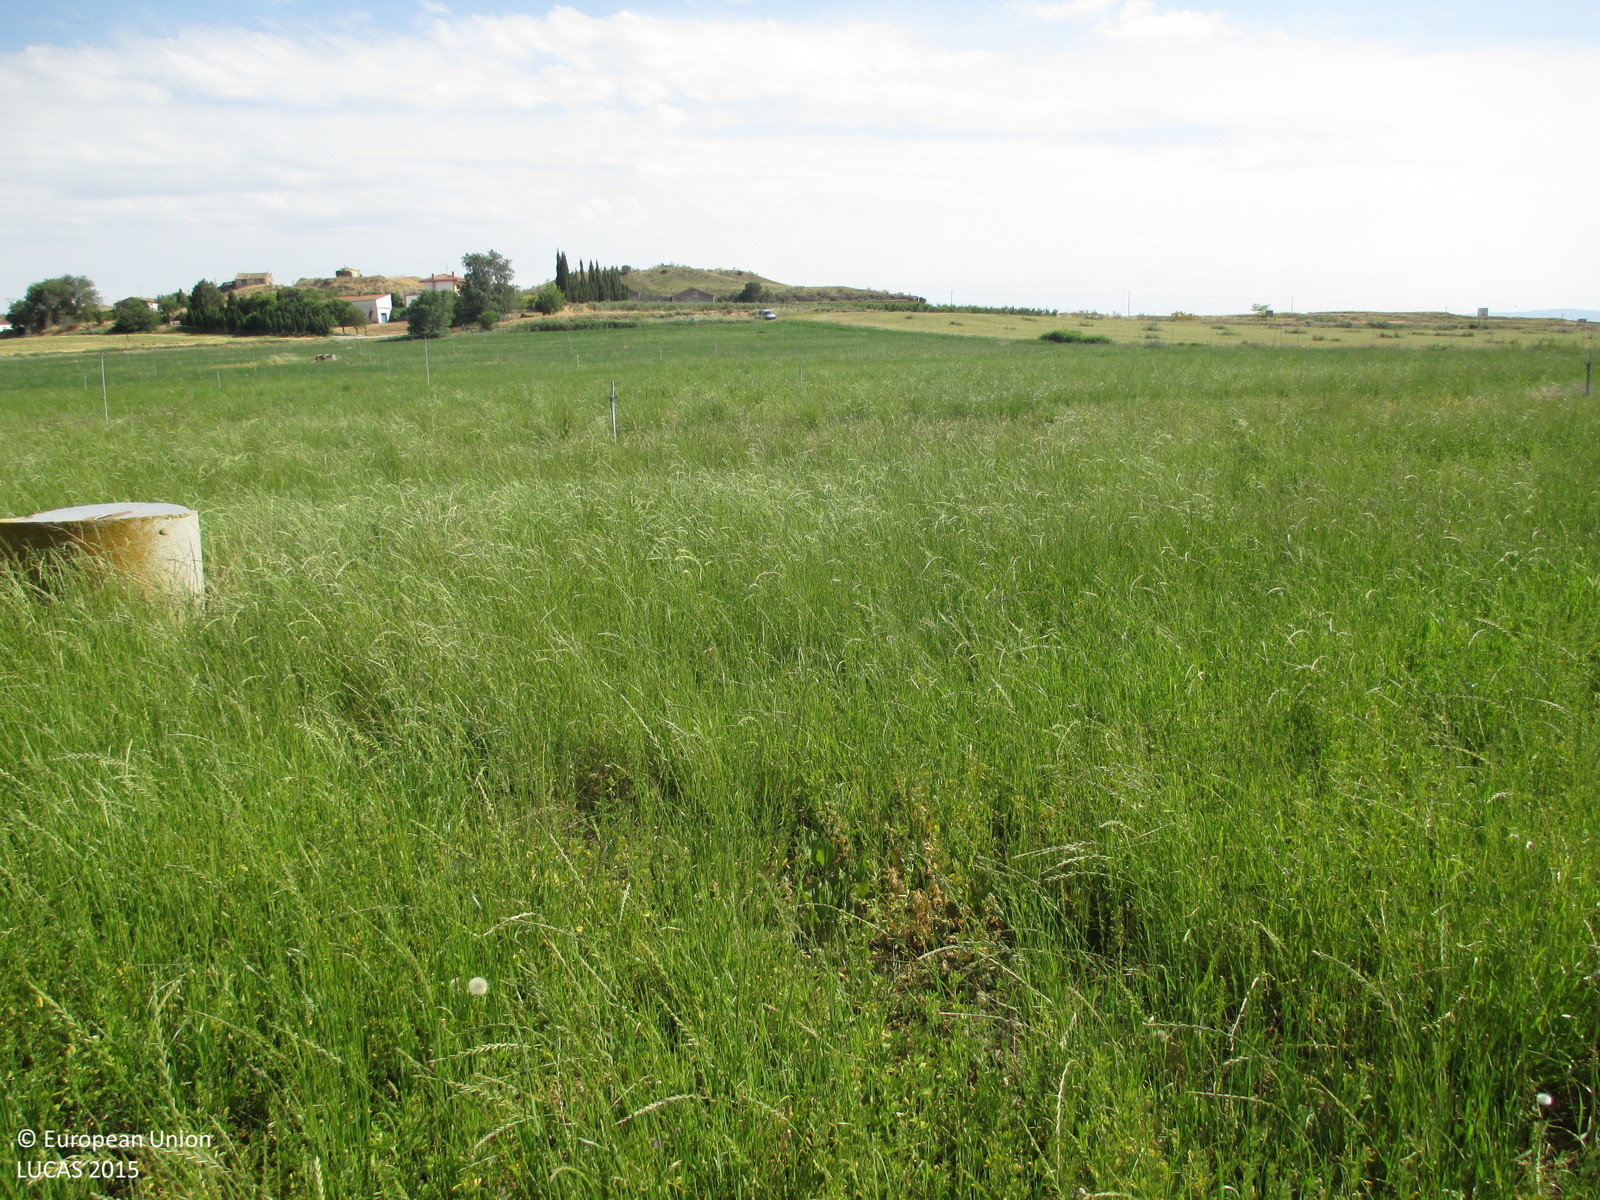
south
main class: Cropland
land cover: Lucerne
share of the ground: > 75 %
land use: Agriculture (excluding fallow land and kitchen gardens)
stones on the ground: < 10 %
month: May
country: ES
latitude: 41.9057
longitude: -0.1572
